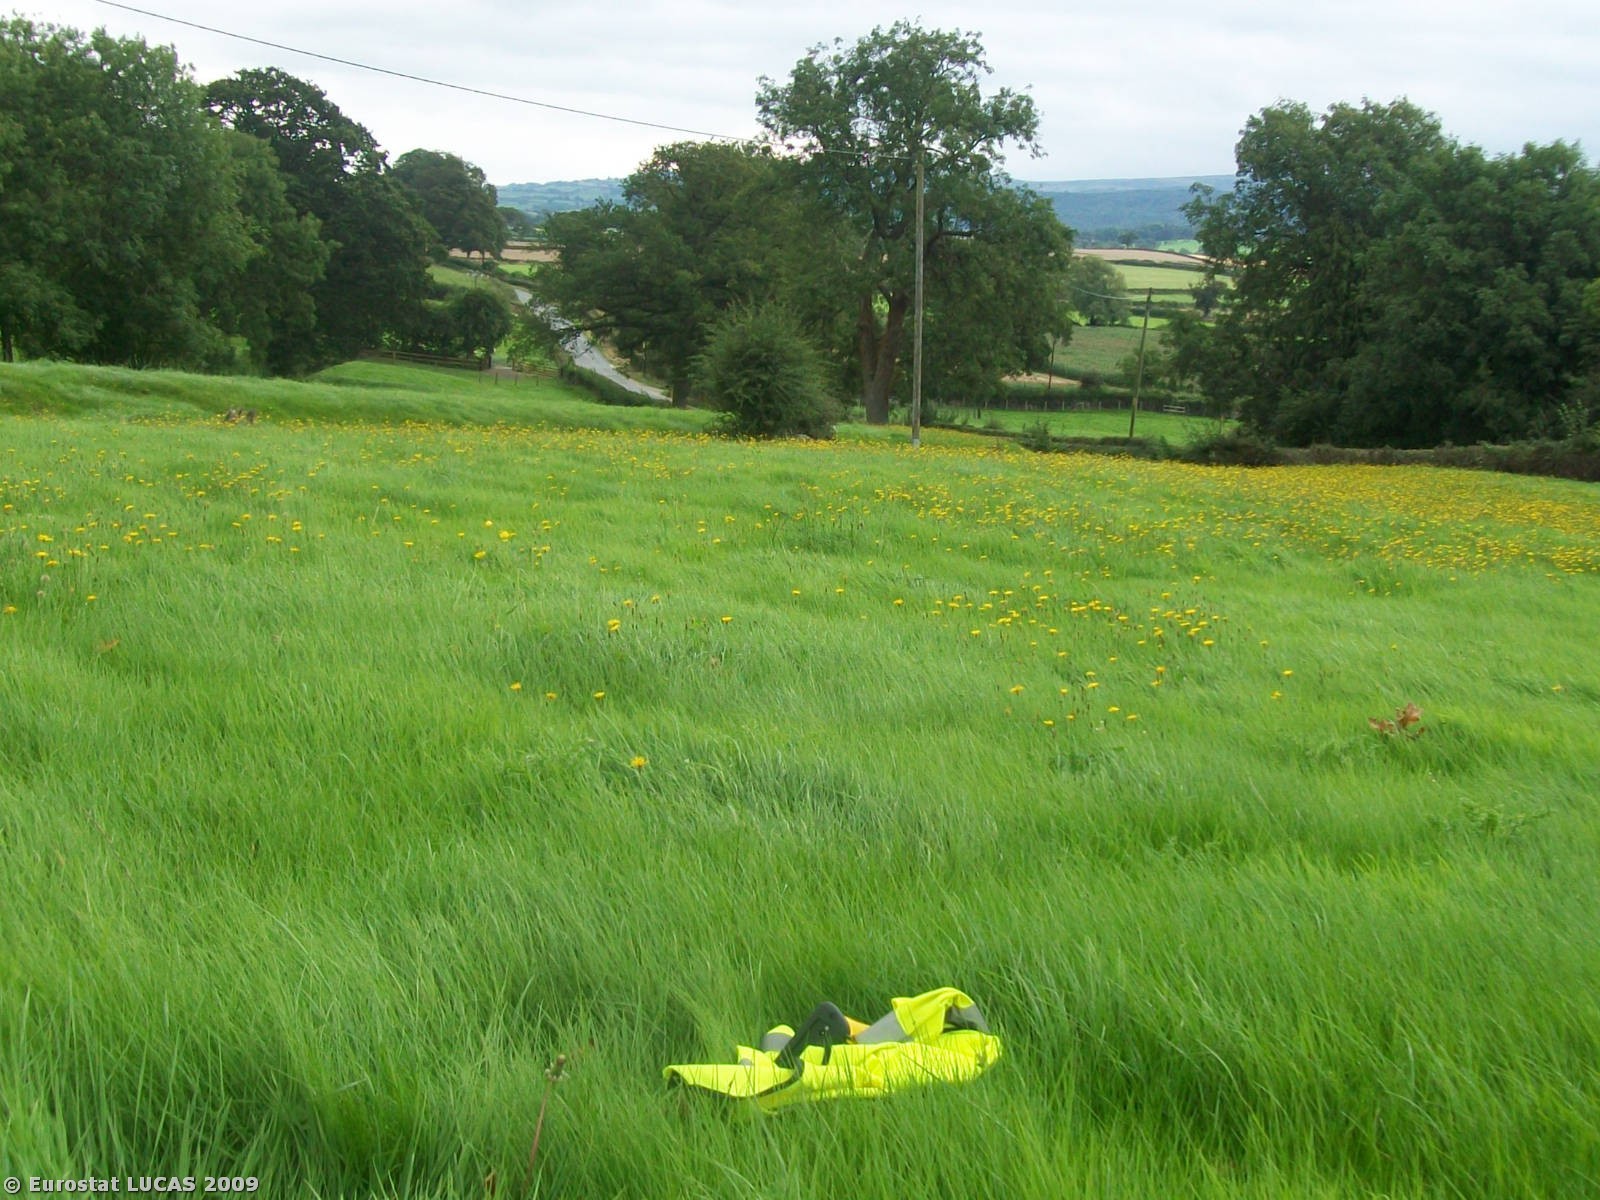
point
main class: Grassland
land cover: Grassland without tree/shrub cover
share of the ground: > 75 %
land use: Agriculture (excluding fallow land and kitchen gardens)
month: August
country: GB
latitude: 52.5906
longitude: -3.1412
